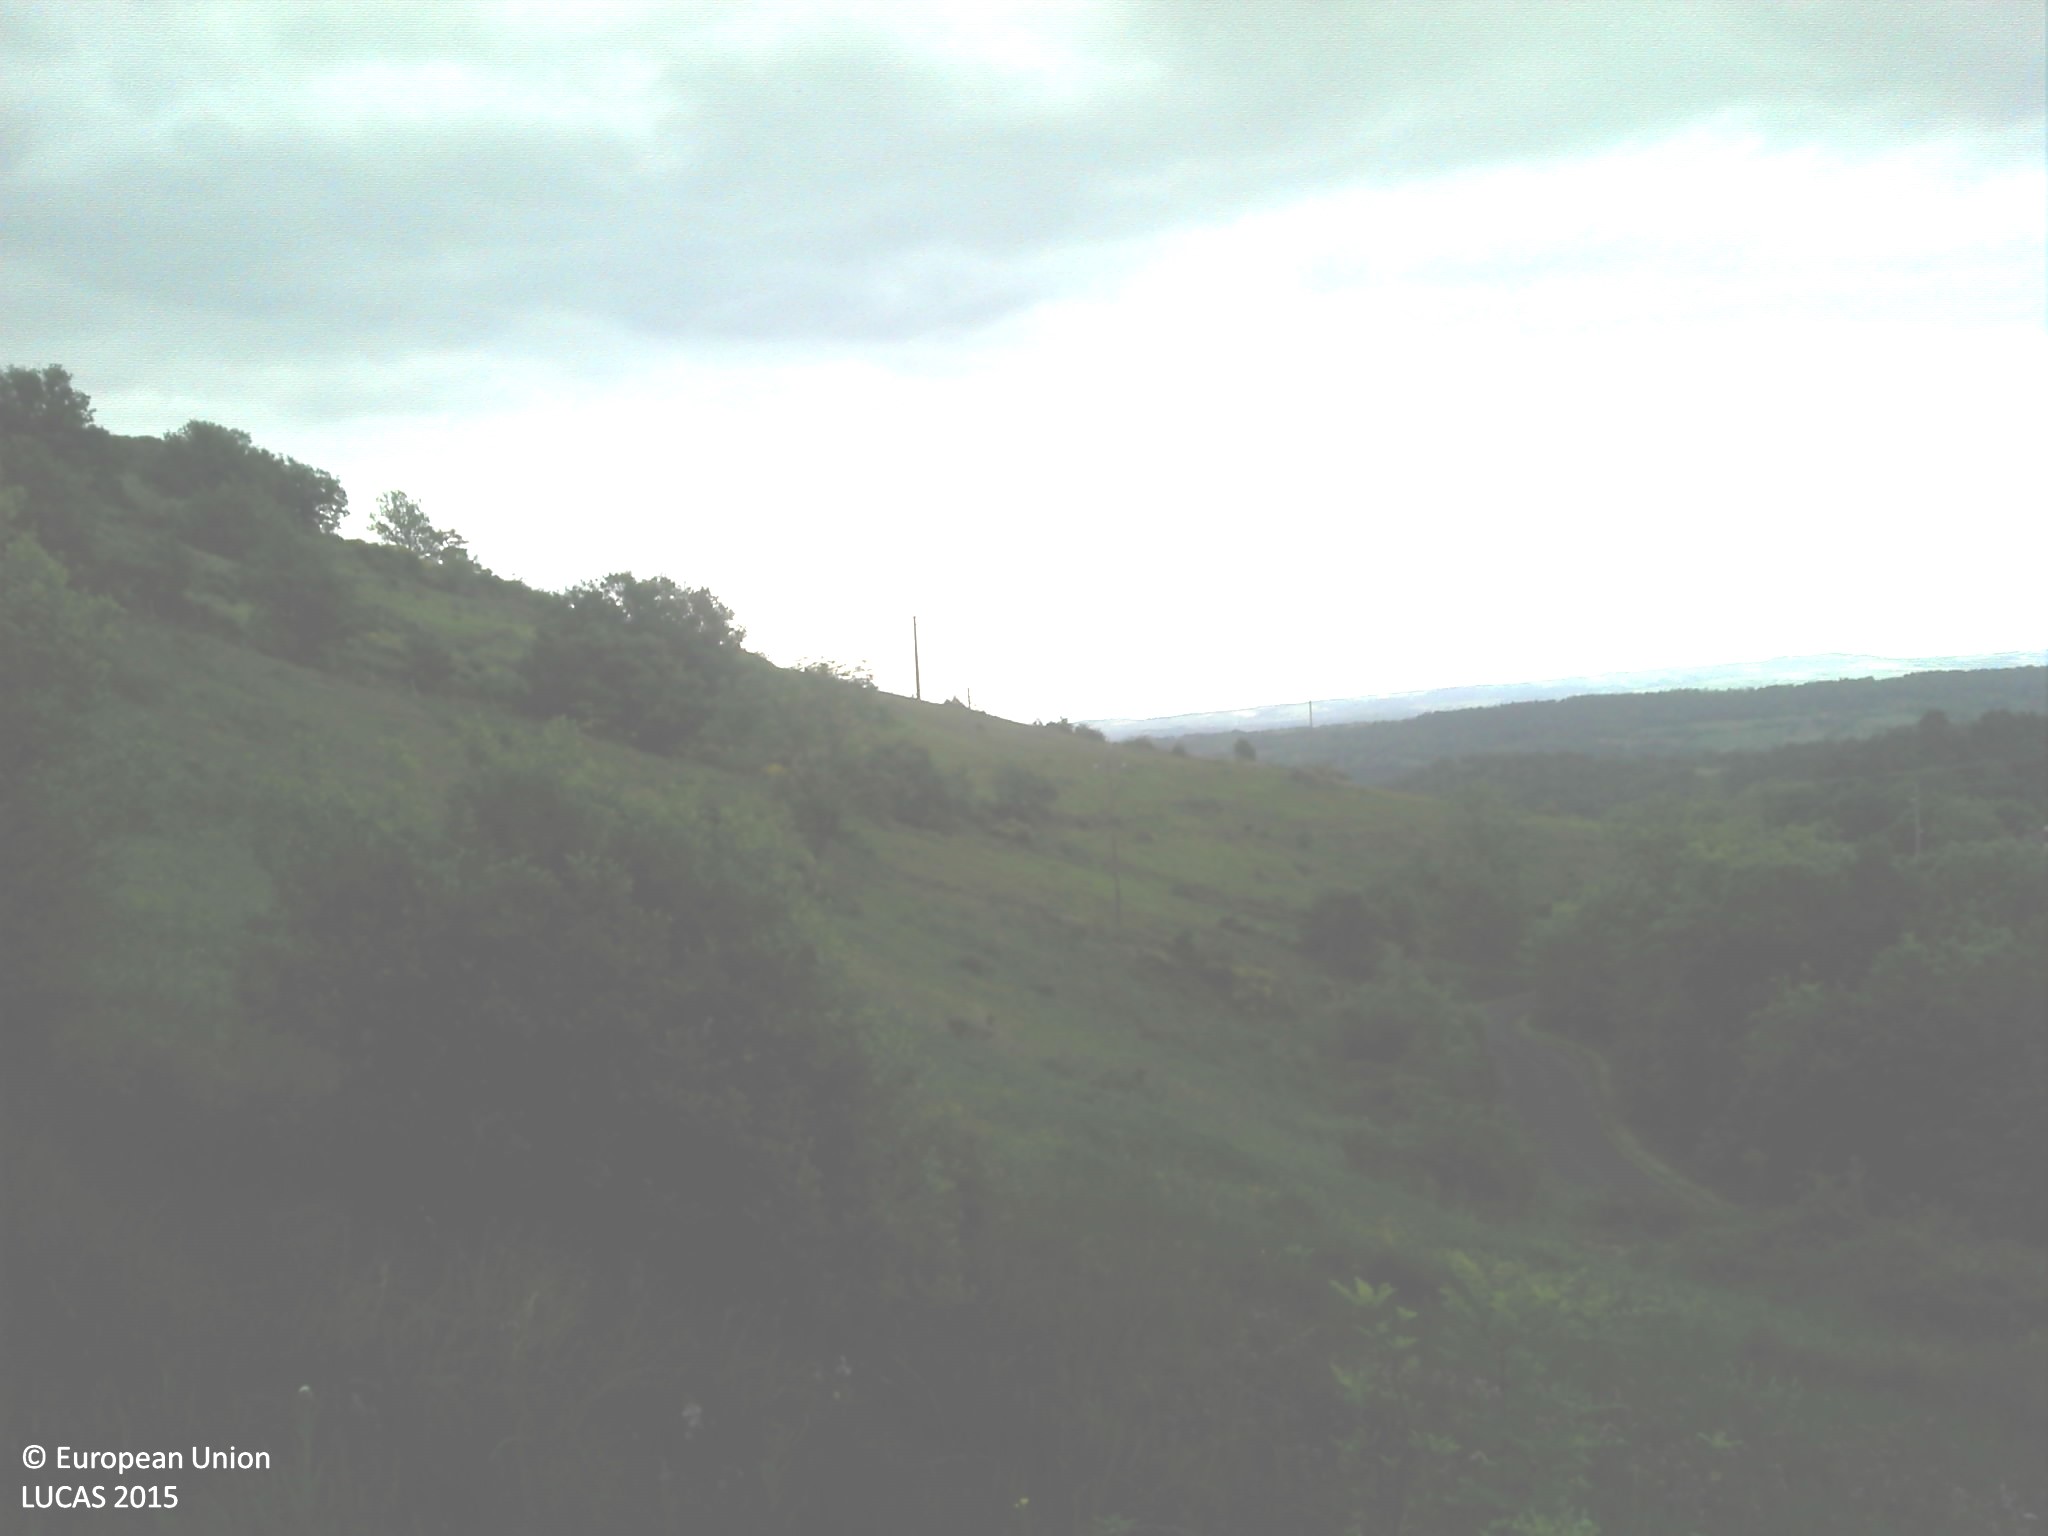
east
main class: Shrubland
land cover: Shrubland without tree cover
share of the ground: > 75 %
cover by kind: herbaceous plants 60 %, shrubs 40 %
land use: Agriculture (excluding fallow land and kitchen gardens)
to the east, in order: Shrubland without tree cover; Grassland with sparse tree/shrub cover; Fences; Abandoned hedges; Shrubland without tree cover; Tracks; Grassland with sparse tree/shrub cover; Shrubland without tree cover
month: May
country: FR
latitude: 45.2789
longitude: 3.1049
